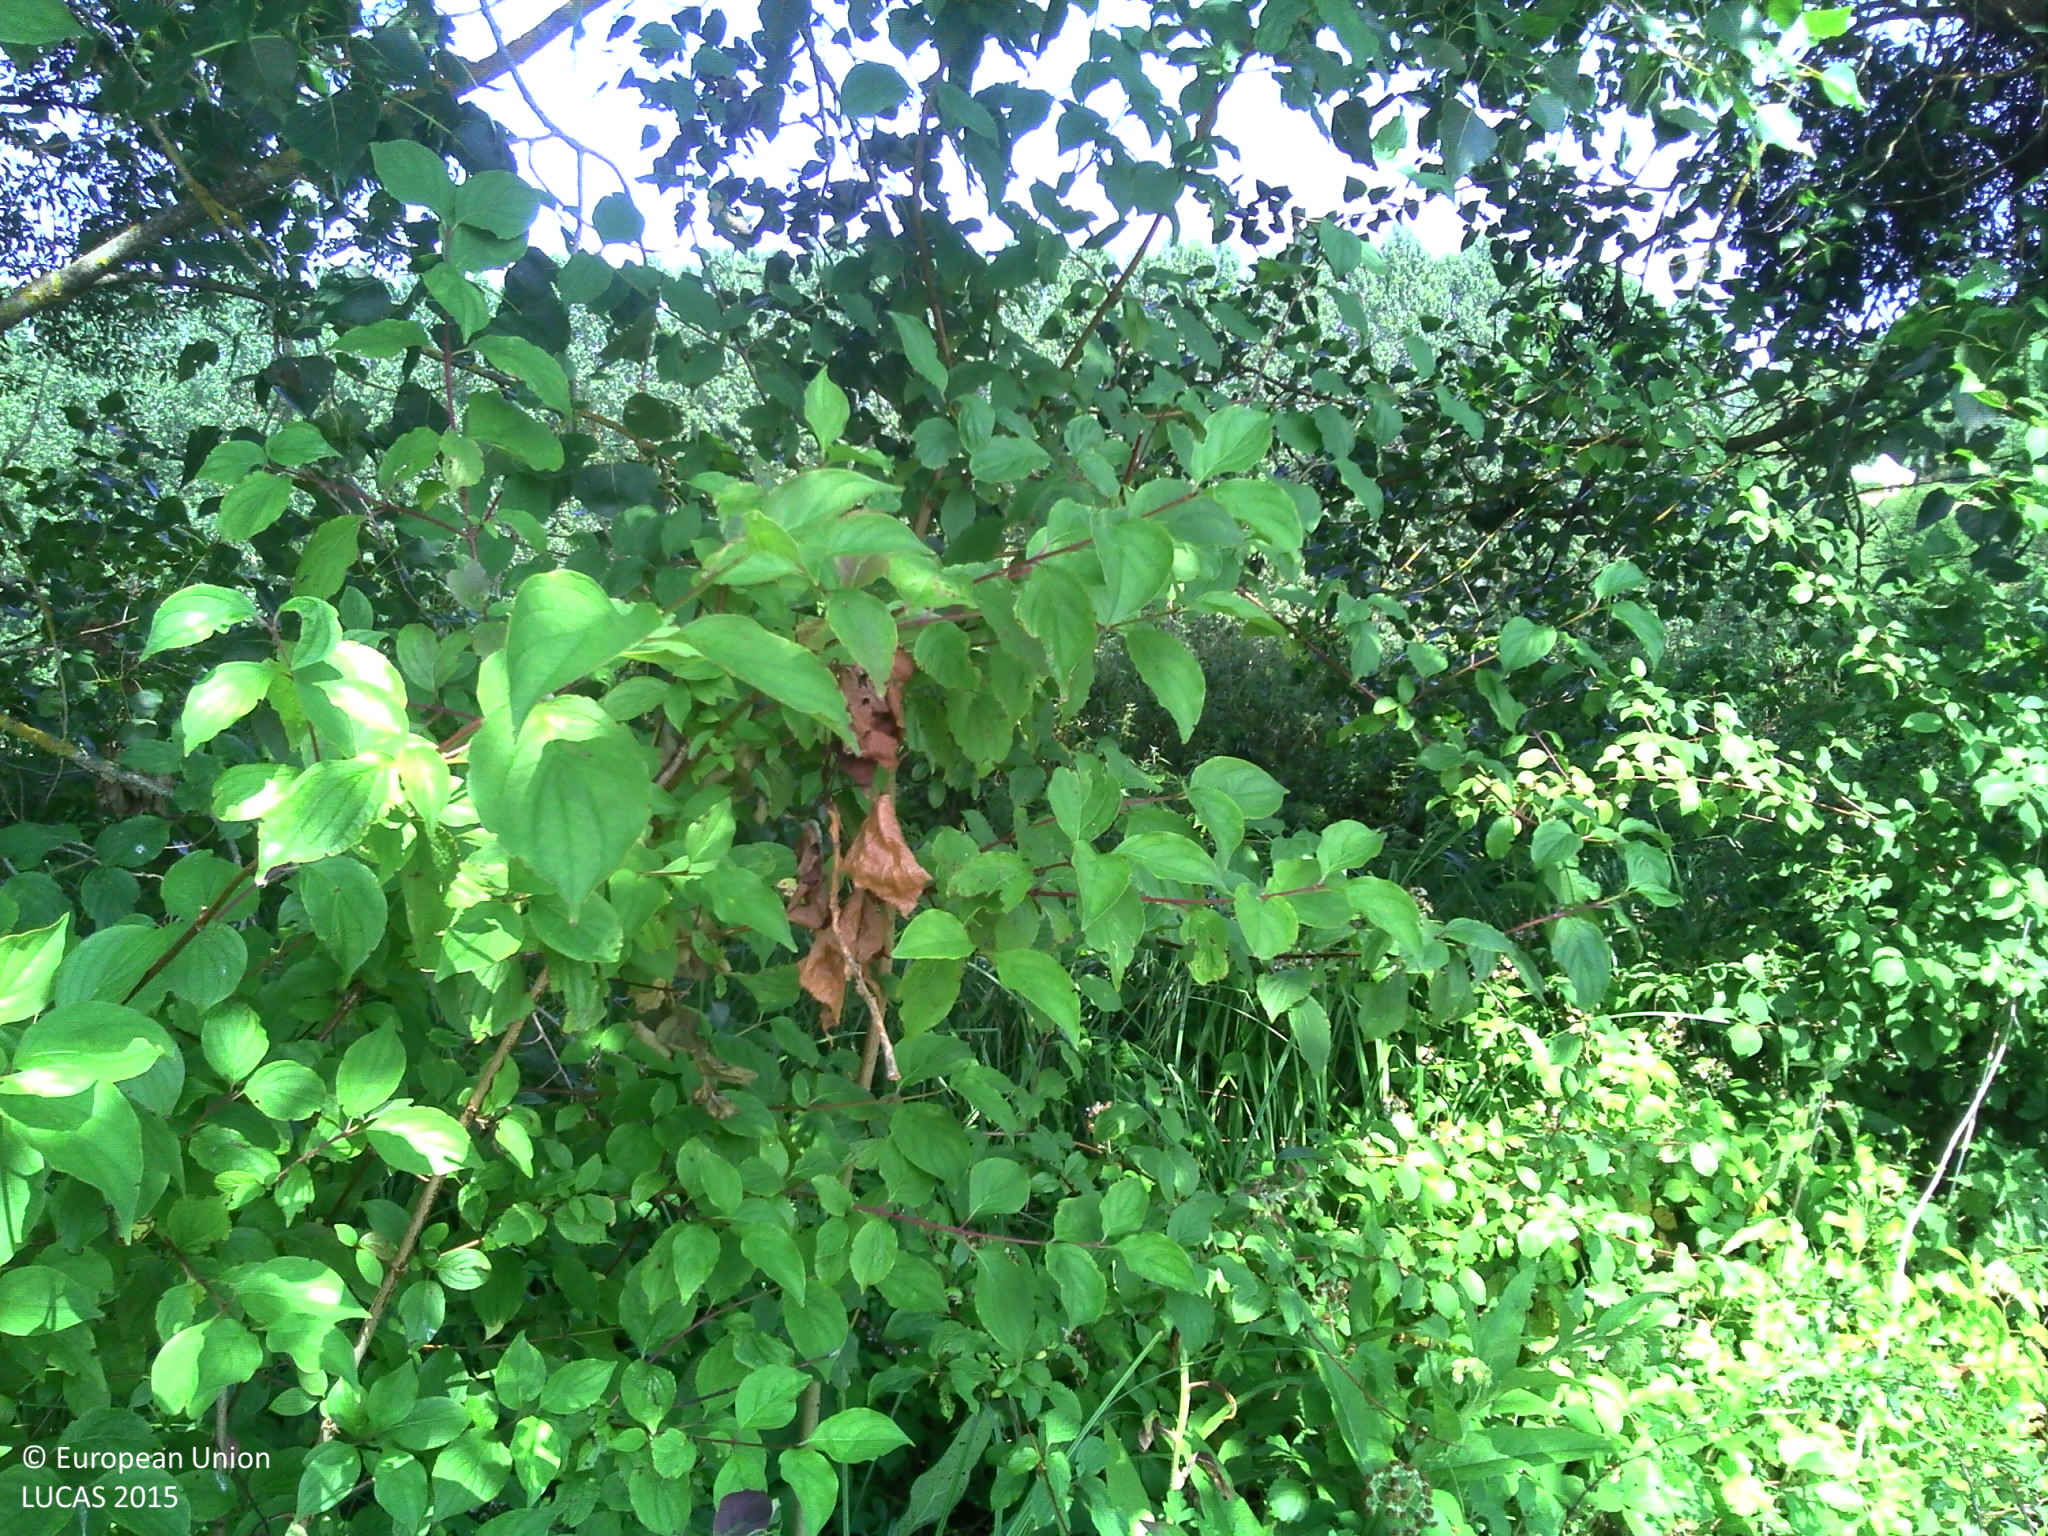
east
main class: Woodland
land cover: Broadleaved woodland
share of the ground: > 75 %
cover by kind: broadleaved forest trees 70 %, herbaceous plants 15 %, consolidated bare surface 15 %
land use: Semi-natural and natural areas not in use
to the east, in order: Broadleaved woodland; Rivers and streams; Grassland without tree/shrub cover; Common wheat; Grassland without tree/shrub cover; Abandoned hedges; Inland fresh running water; Abandoned hedges; Paved roads, cycling and walking lanes; Fences; Managed hedges; Grassland without tree/shrub cover; Broadleaved woodland; Tracks; Grassland without tree/shrub cover
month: July
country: FR
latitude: 48.8068
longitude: 1.3625
